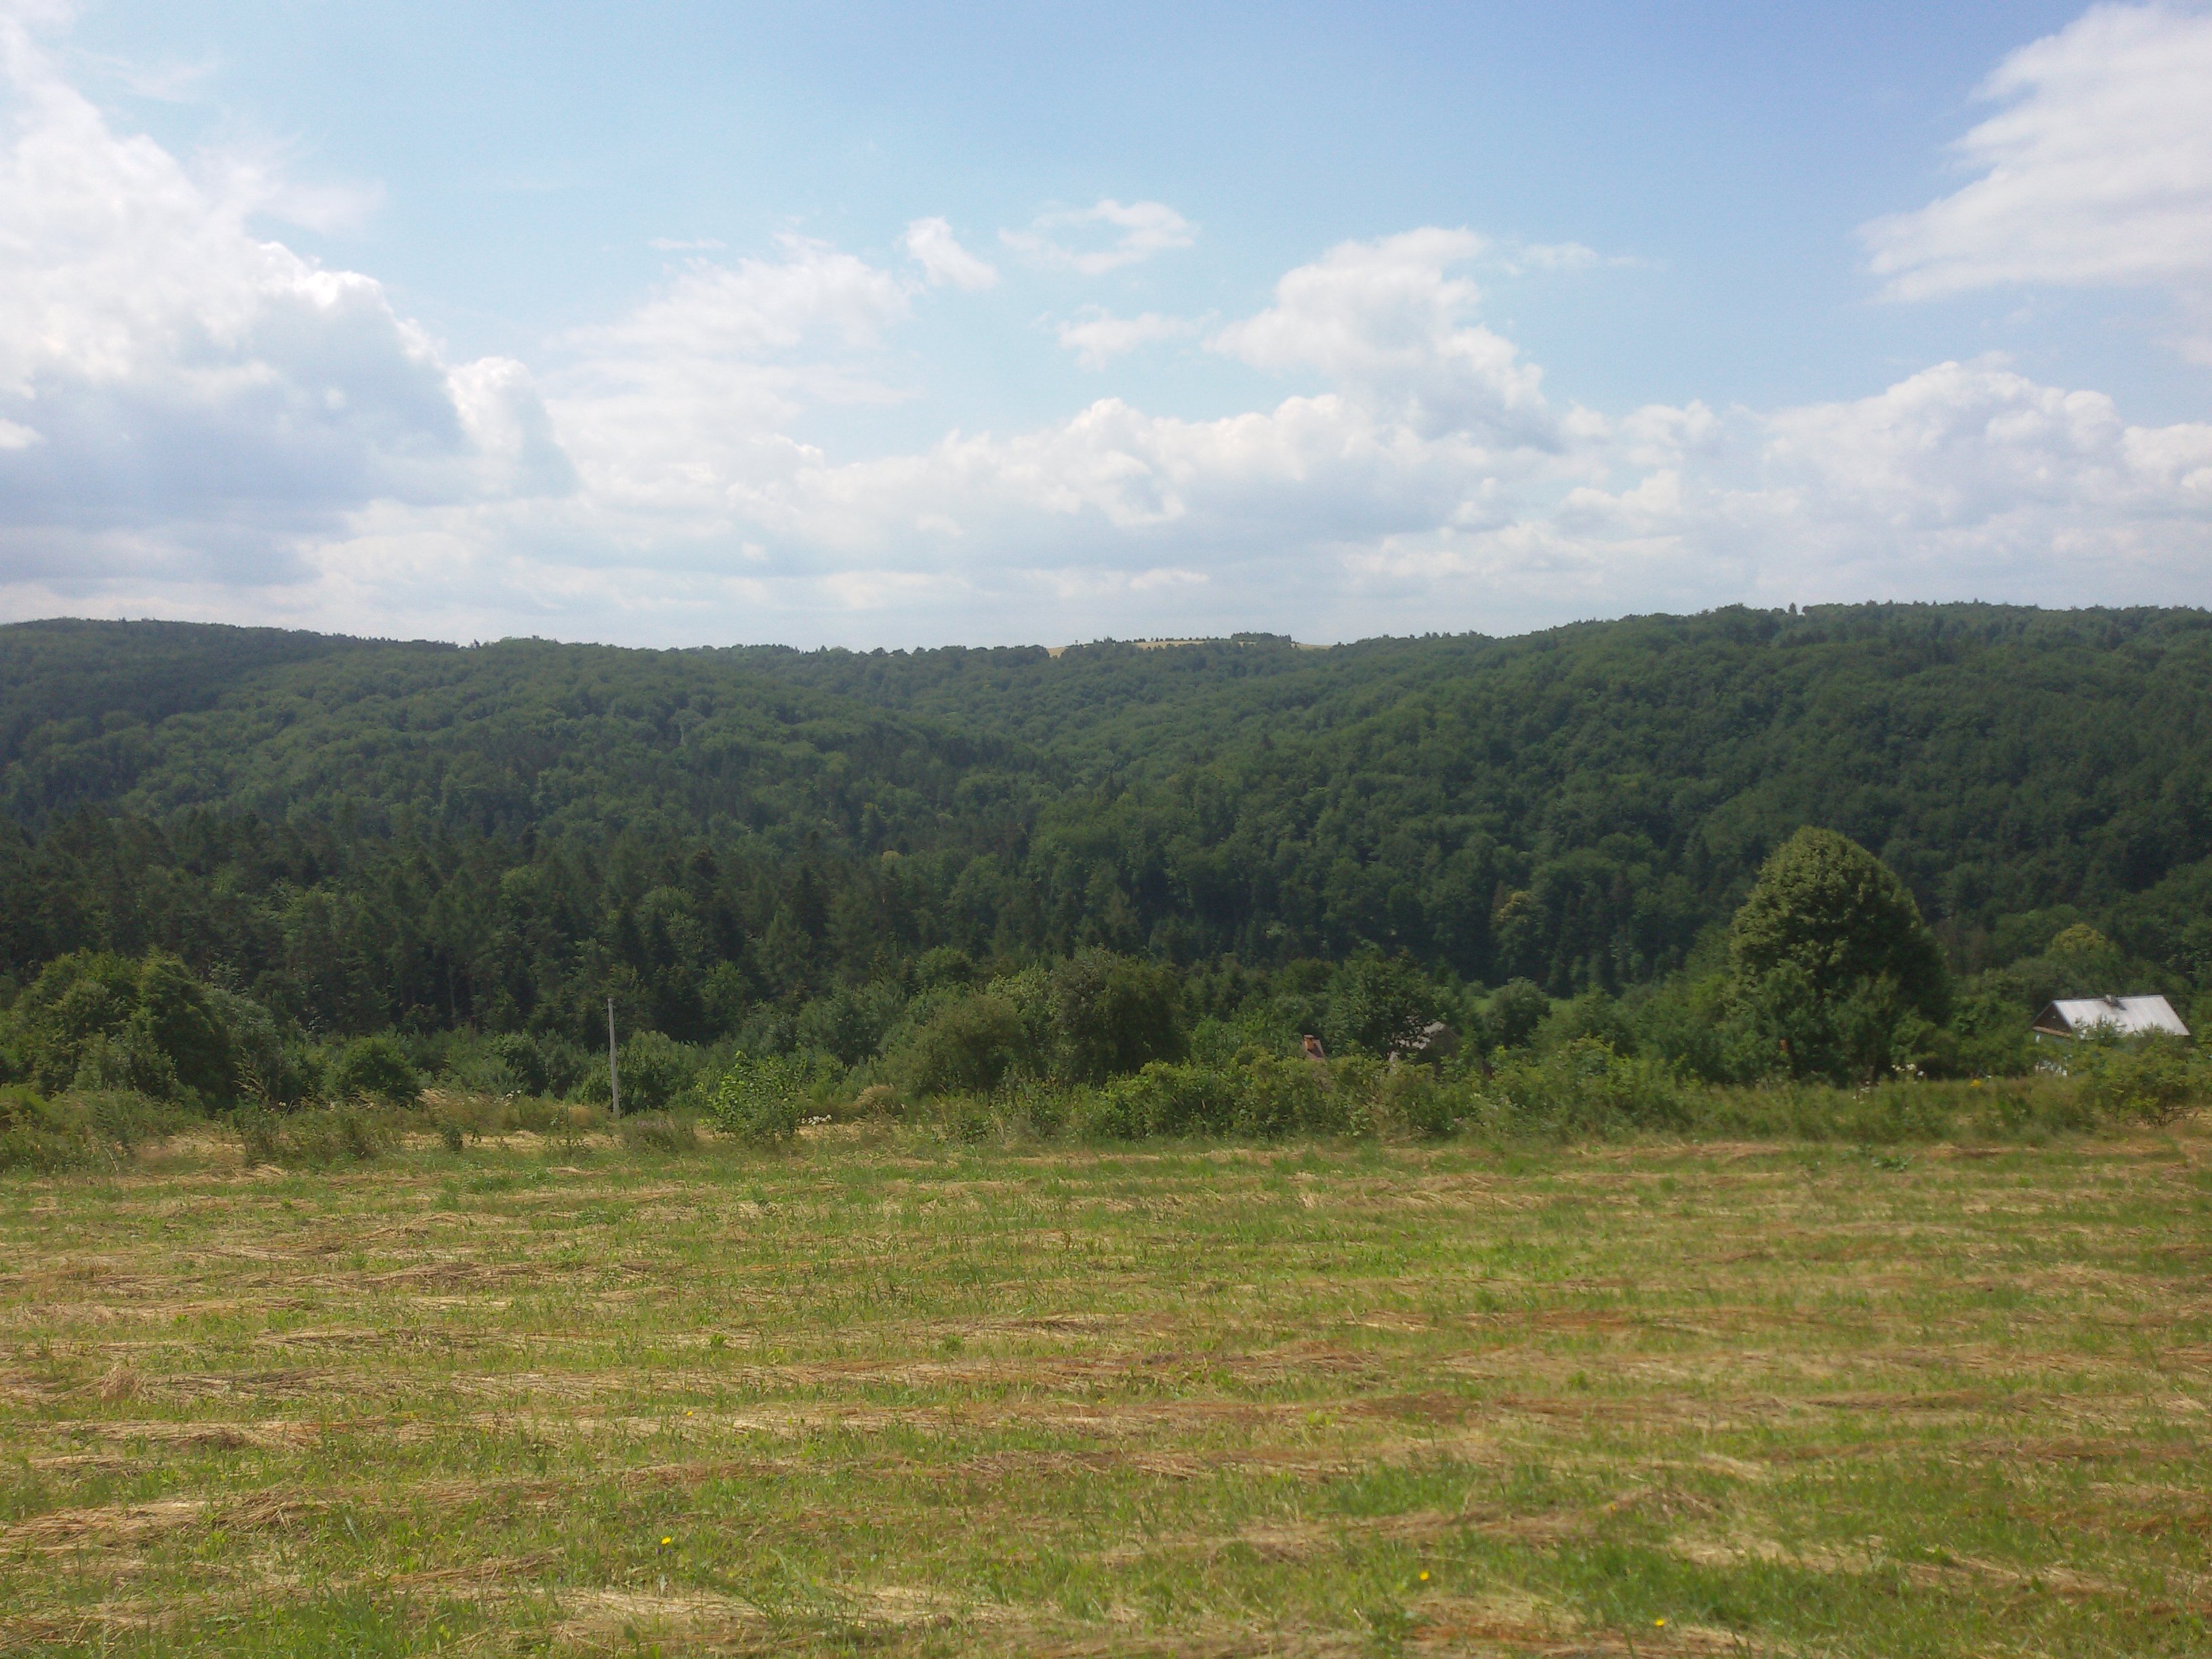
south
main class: Grassland
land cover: Grassland without tree/shrub cover
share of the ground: > 75 %
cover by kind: herbaceous plants 100 %
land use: Agriculture (excluding fallow land and kitchen gardens)
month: July
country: PL
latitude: 49.7735
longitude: 22.2667
